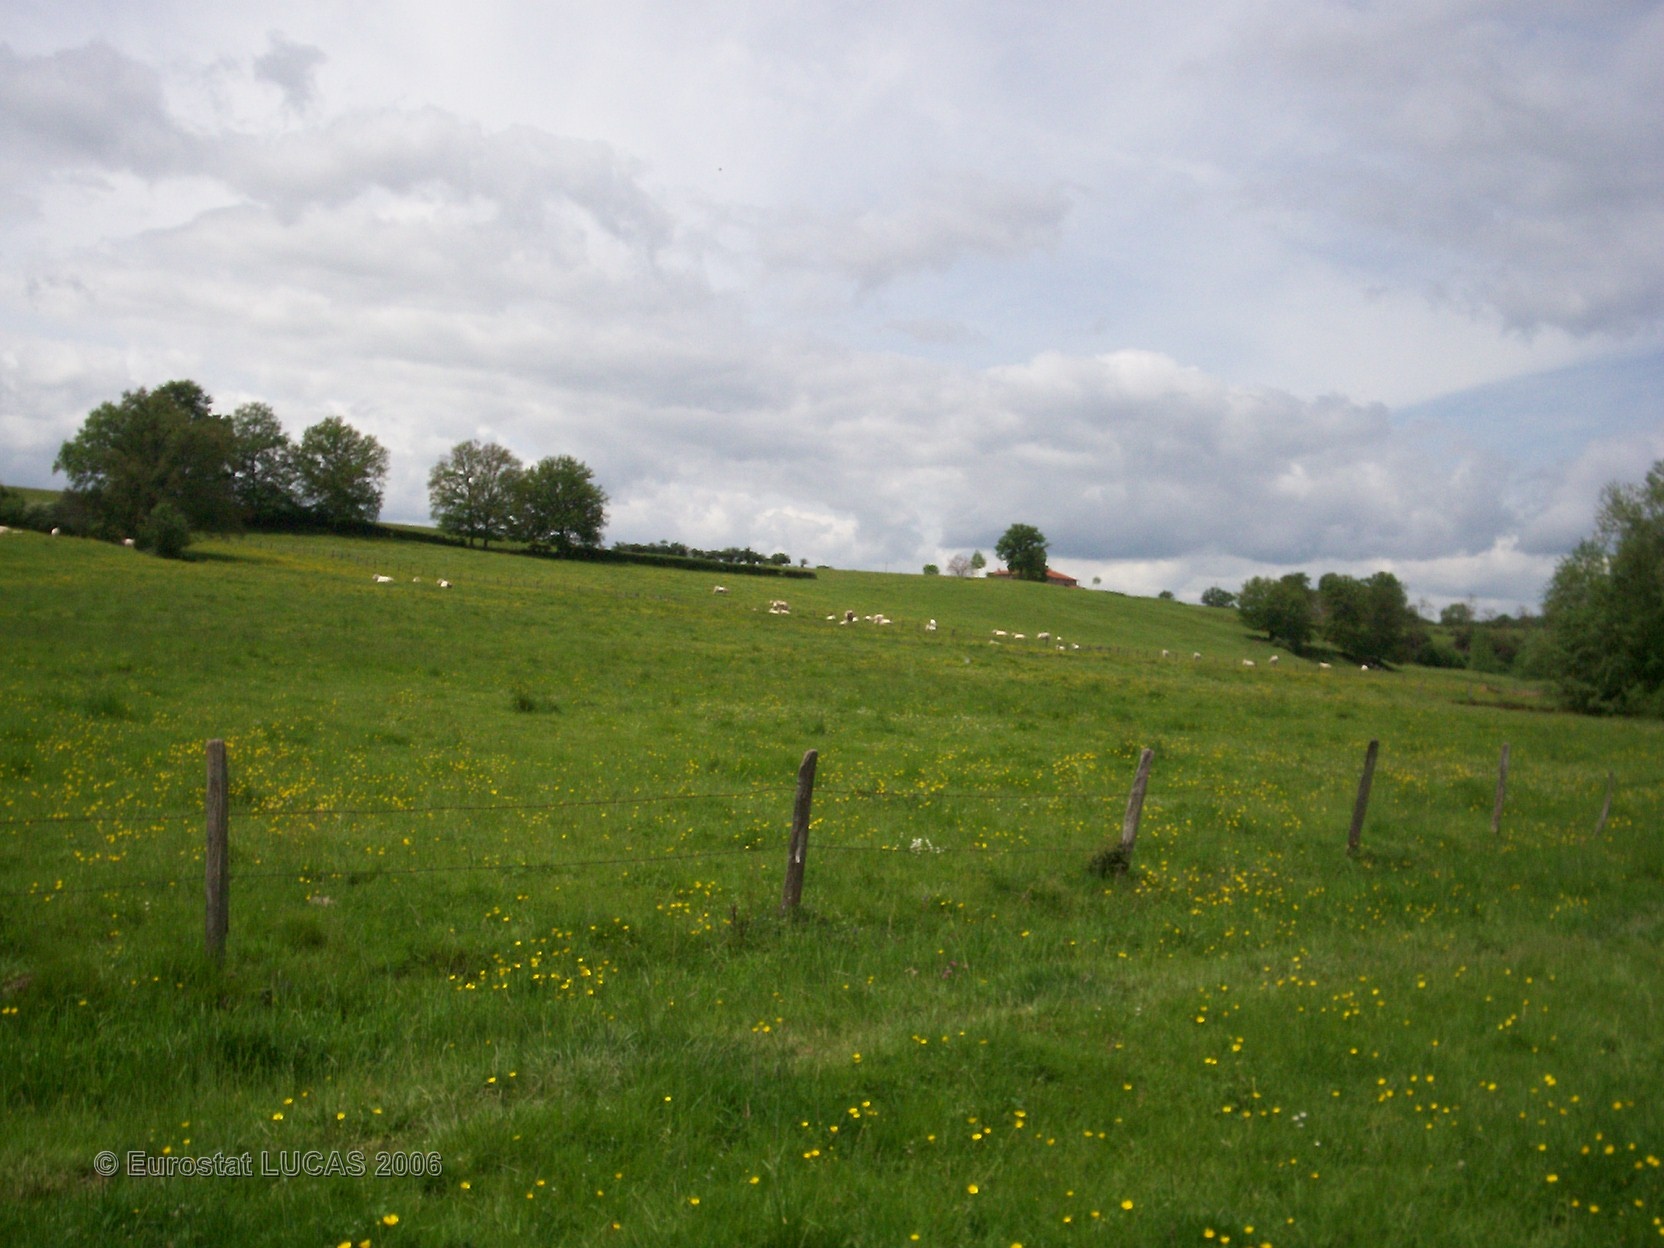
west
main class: Grassland
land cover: Grassland without tree/shrub cover
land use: Agriculture (excluding fallow land and kitchen gardens)
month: May
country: FR
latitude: 46.1183
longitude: 4.1397
